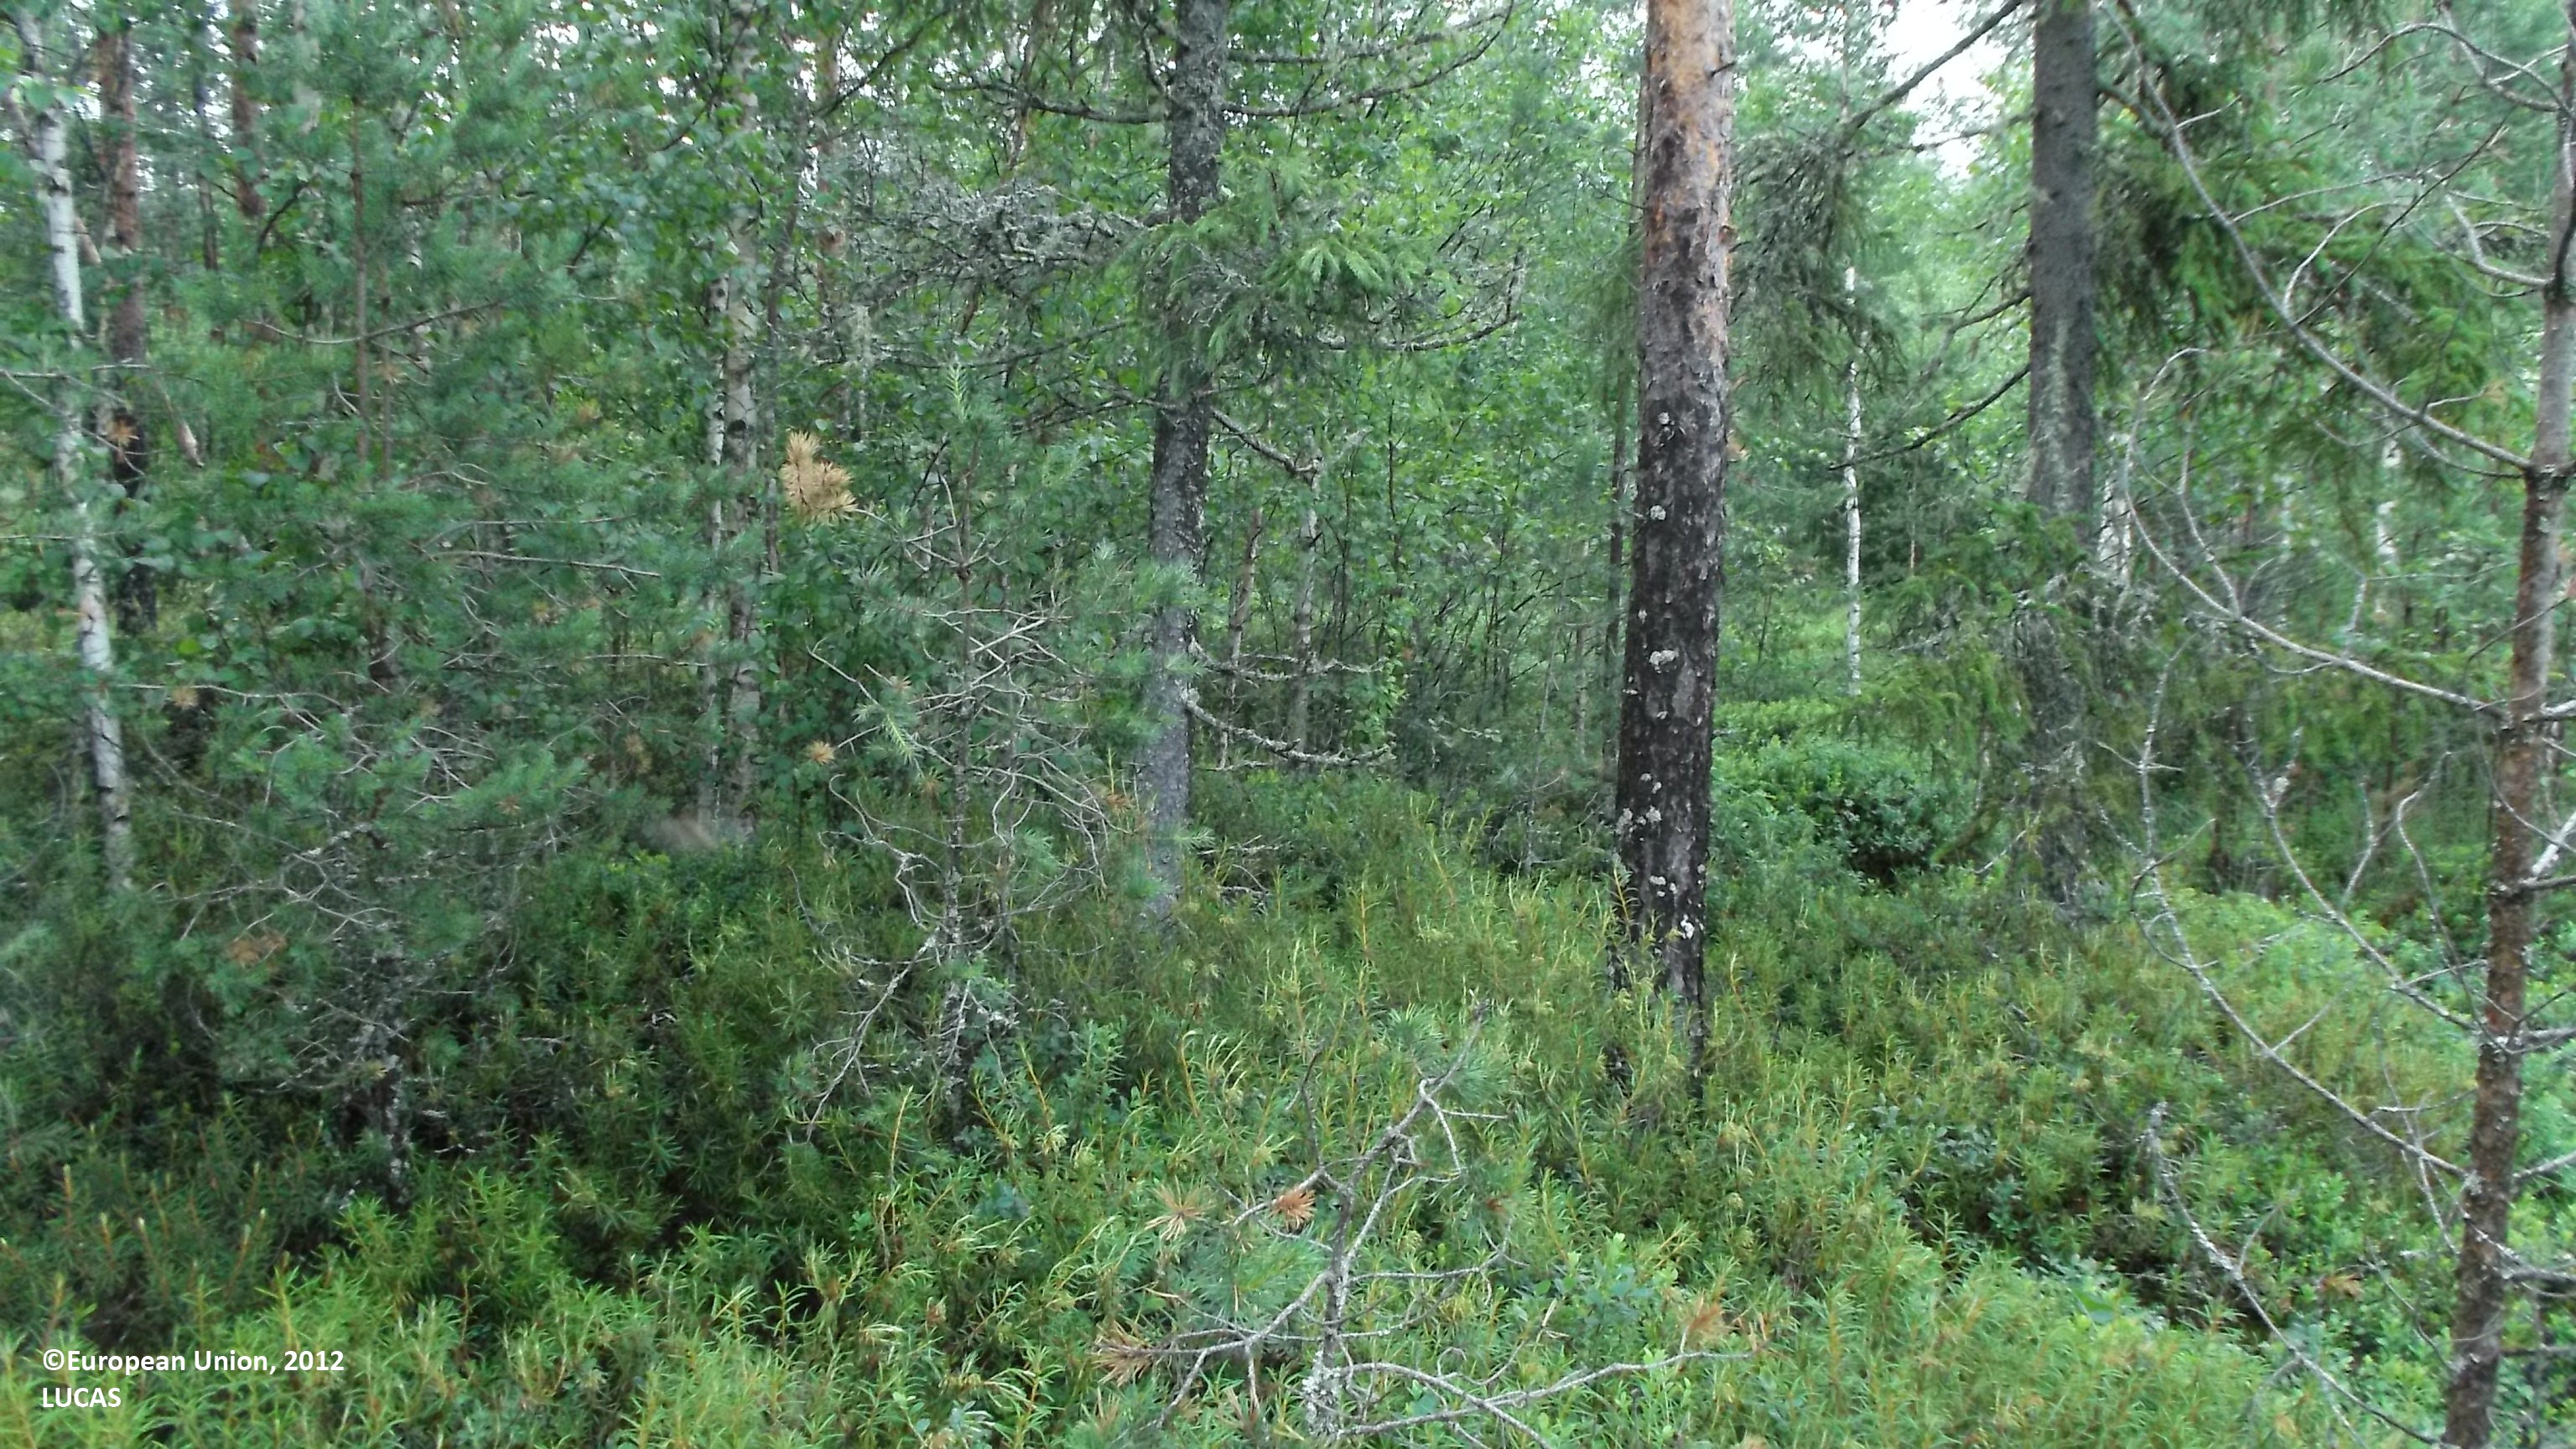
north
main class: Woodland
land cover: Other mixed woodland
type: boreal forest
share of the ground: 50 - 75 %
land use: Forestry
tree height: > 5 m
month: July
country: FI
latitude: 63.3928
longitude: 23.9394
